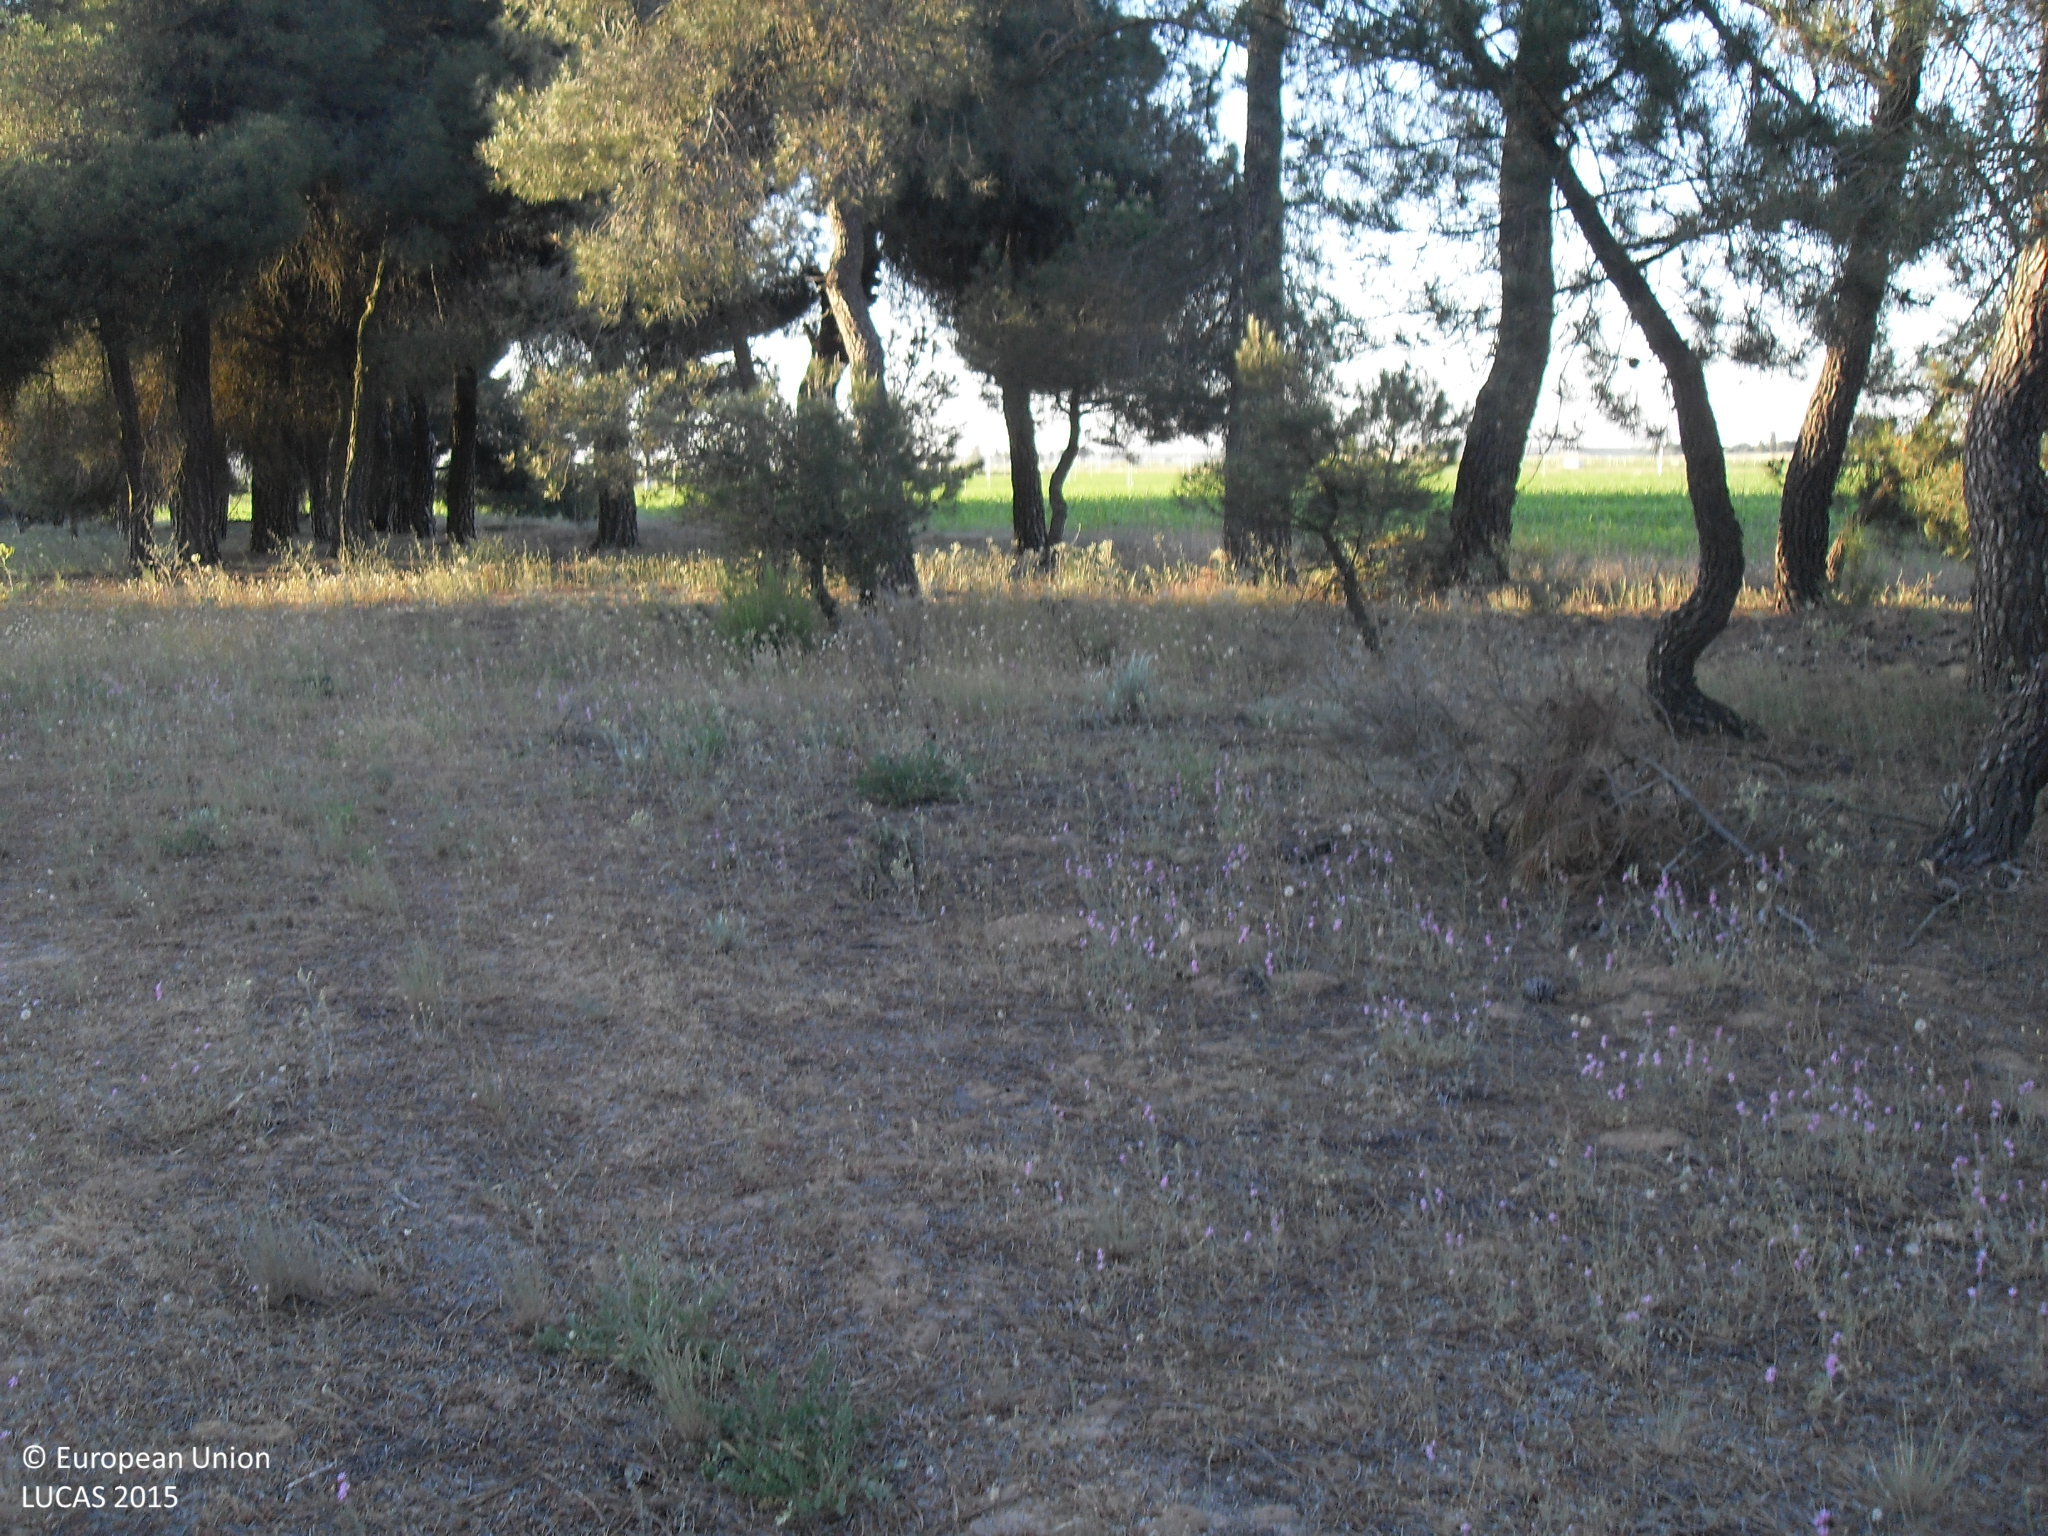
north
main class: Woodland
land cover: Pine dominated coniferous woodland
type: coniferous forest of the mediterranean region
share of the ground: 25 - 50 %
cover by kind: consolidated bare surface 60 %, coniferous forest trees 40 %
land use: Forestry
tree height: > 5 m
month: May
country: ES
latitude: 41.0306
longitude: -5.3803
